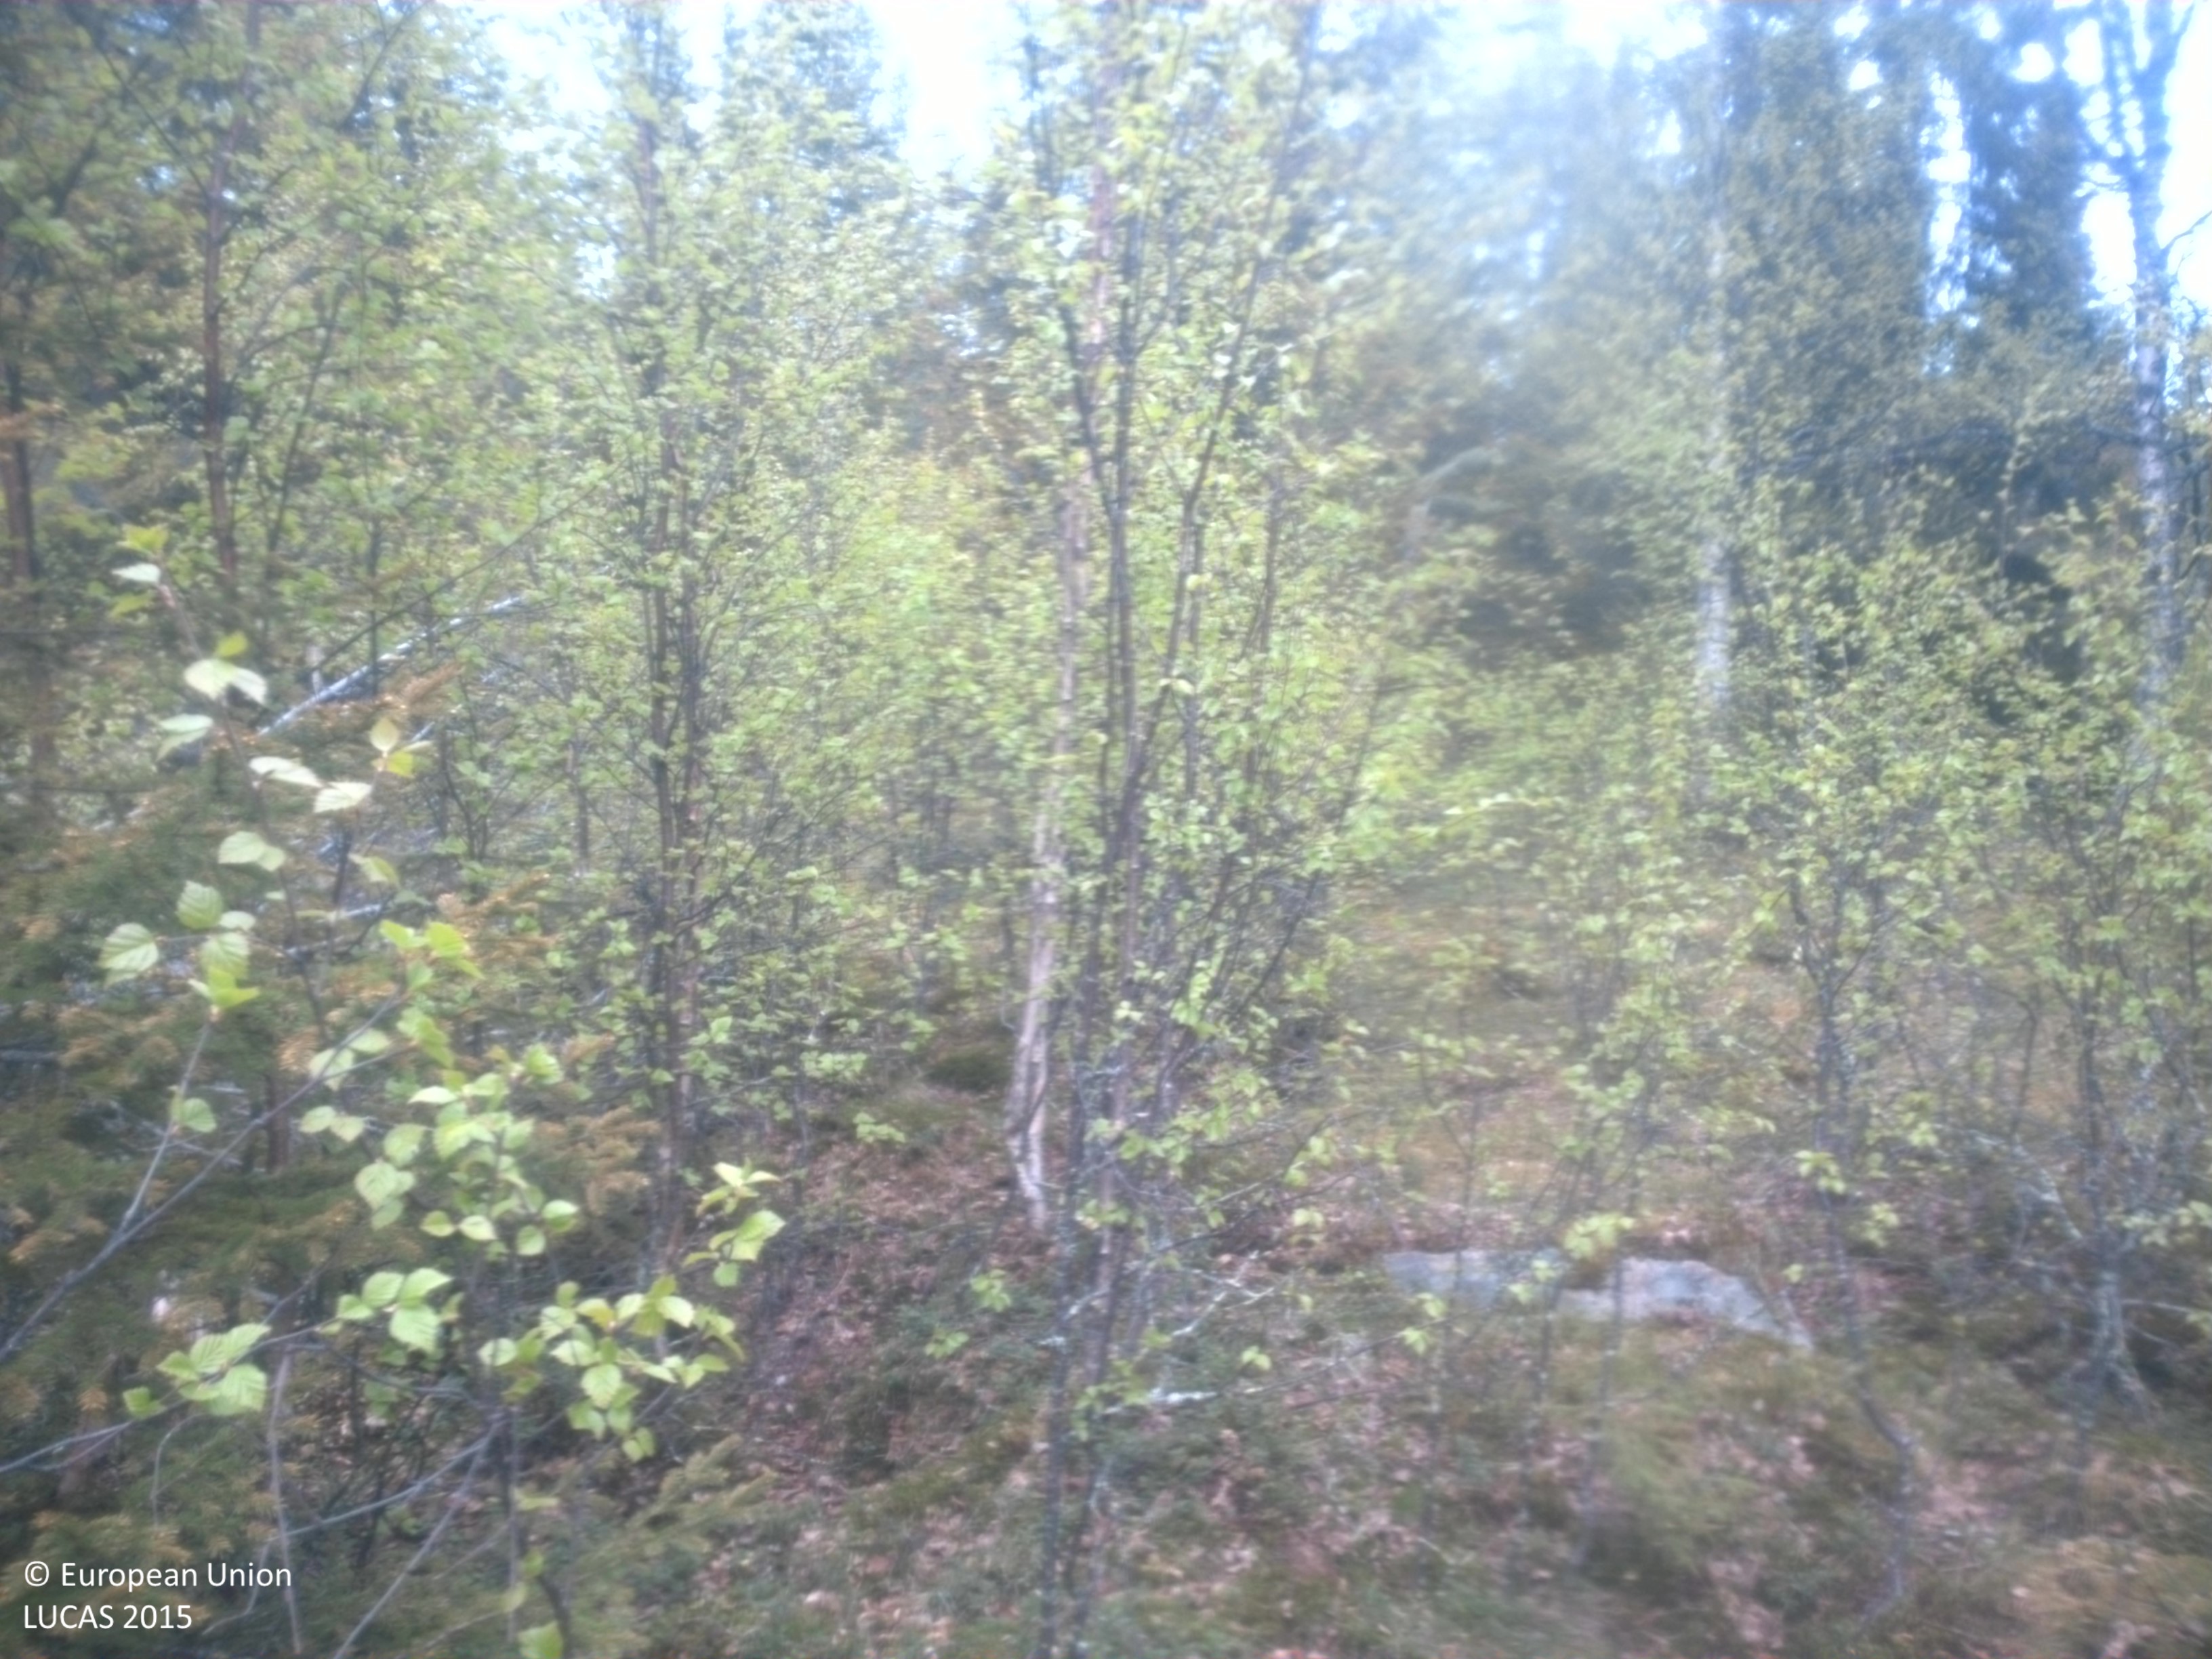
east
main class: Woodland
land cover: Broadleaved woodland
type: boreal forest
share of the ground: 25 - 50 %
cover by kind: broadleaved forest trees 35 %, herbaceous plants 35 %, lichens and mosses 15 %, unconsolidated bare surface 10 %, coniferous forest trees 5 %
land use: Forestry
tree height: < 5 m
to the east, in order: Broadleaved woodland; Spruce dominated coniferous woodland; Rocks and stones; Spruce dominated coniferous woodland; Rocks and stones; Pine dominated mixed woodland; Pine dominated coniferous woodland; Broadleaved woodland
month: June
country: SE
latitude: 64.3906
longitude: 17.7440
